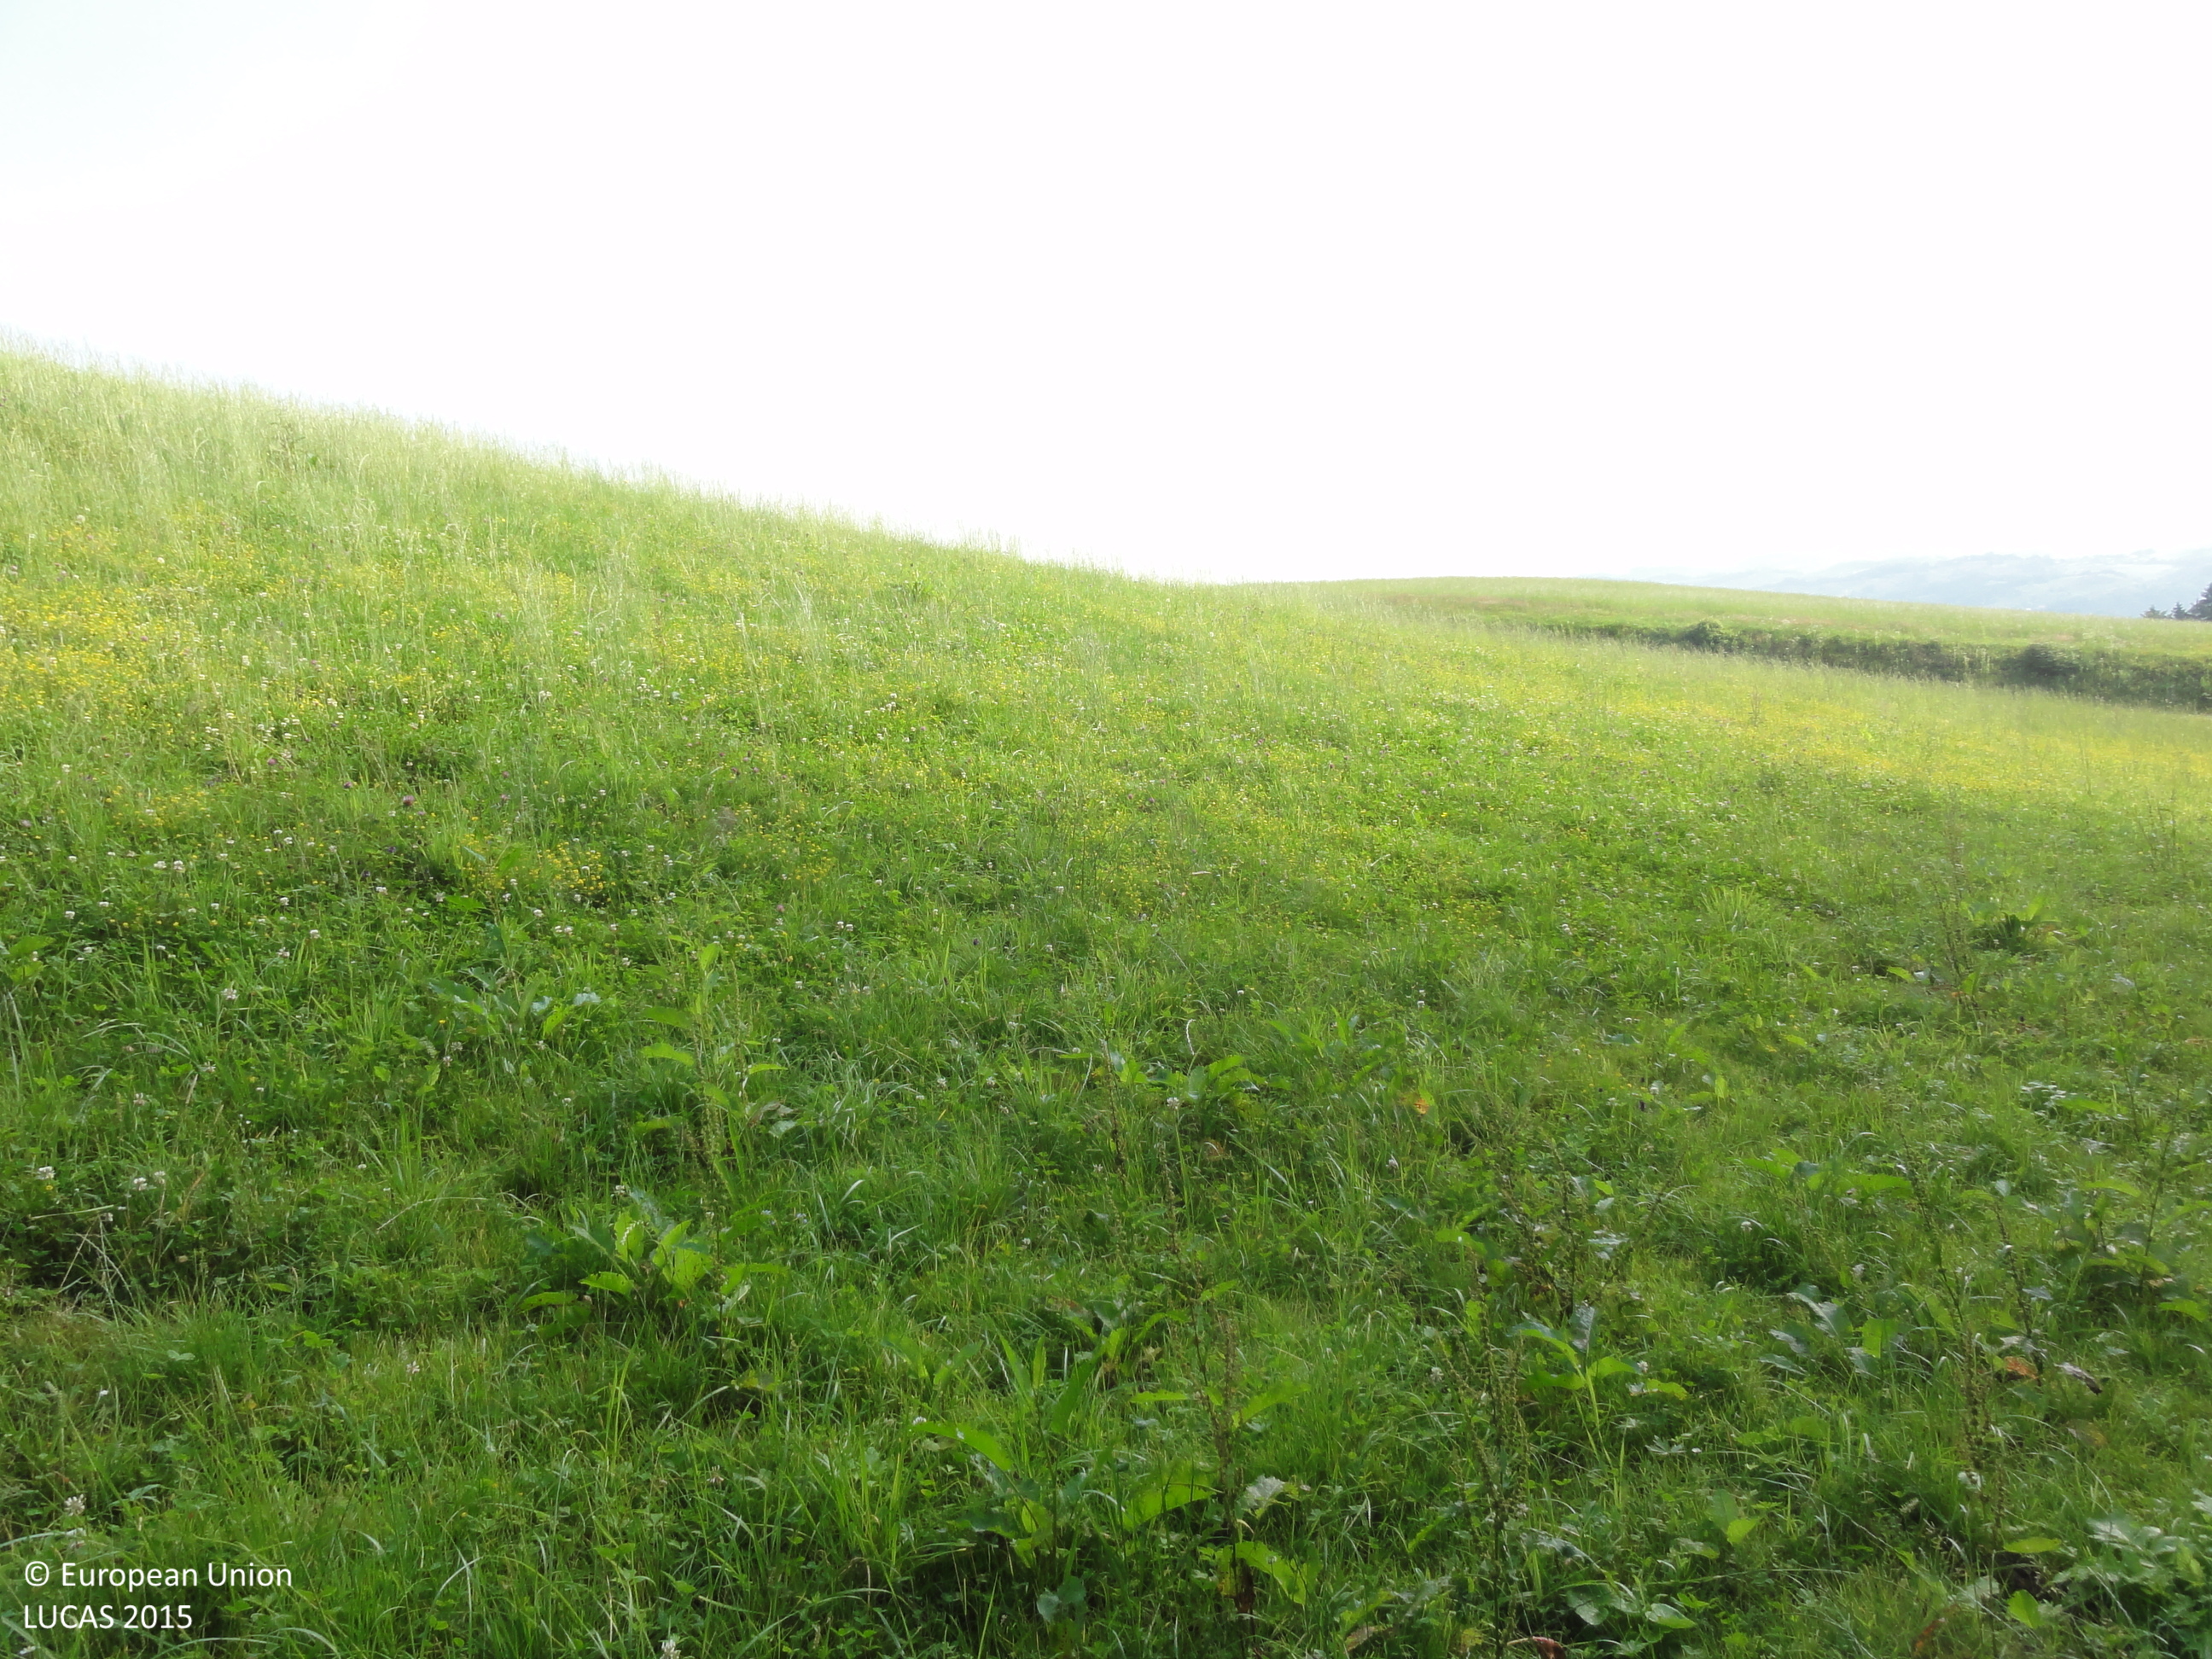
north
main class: Shrubland
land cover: Shrubland with sparse tree cover
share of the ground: > 75 %
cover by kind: shrubs 95 %, broadleaved forest trees 5 %
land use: Forestry
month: July
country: SI
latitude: 46.6223
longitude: 15.5494
